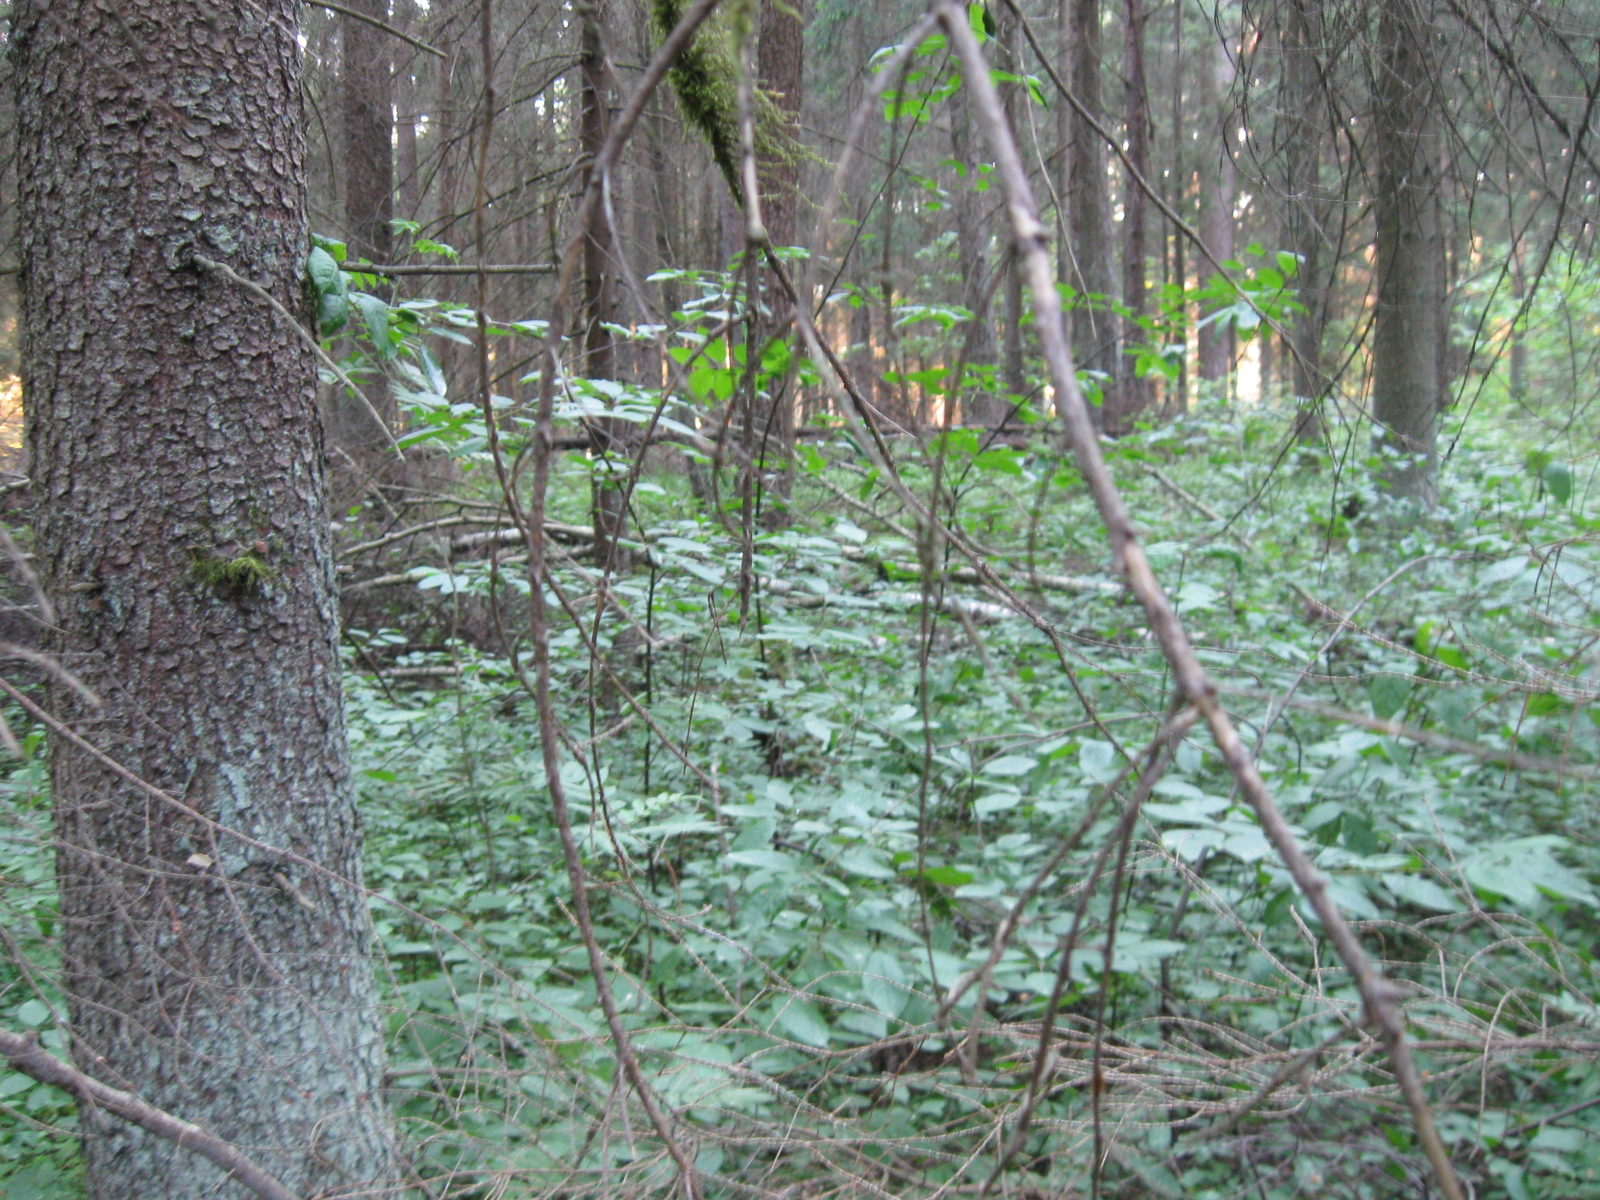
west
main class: Woodland
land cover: Spruce dominated mixed woodland
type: hemiboreal forest and nemoral coniferous forest and mixed broadleaved-coniferous forest
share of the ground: > 75 %
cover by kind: coniferous forest trees 70 %, broadleaved forest trees 30 %
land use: Forestry
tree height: > 5 m
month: June
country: LT
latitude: 54.1518
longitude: 23.6984
